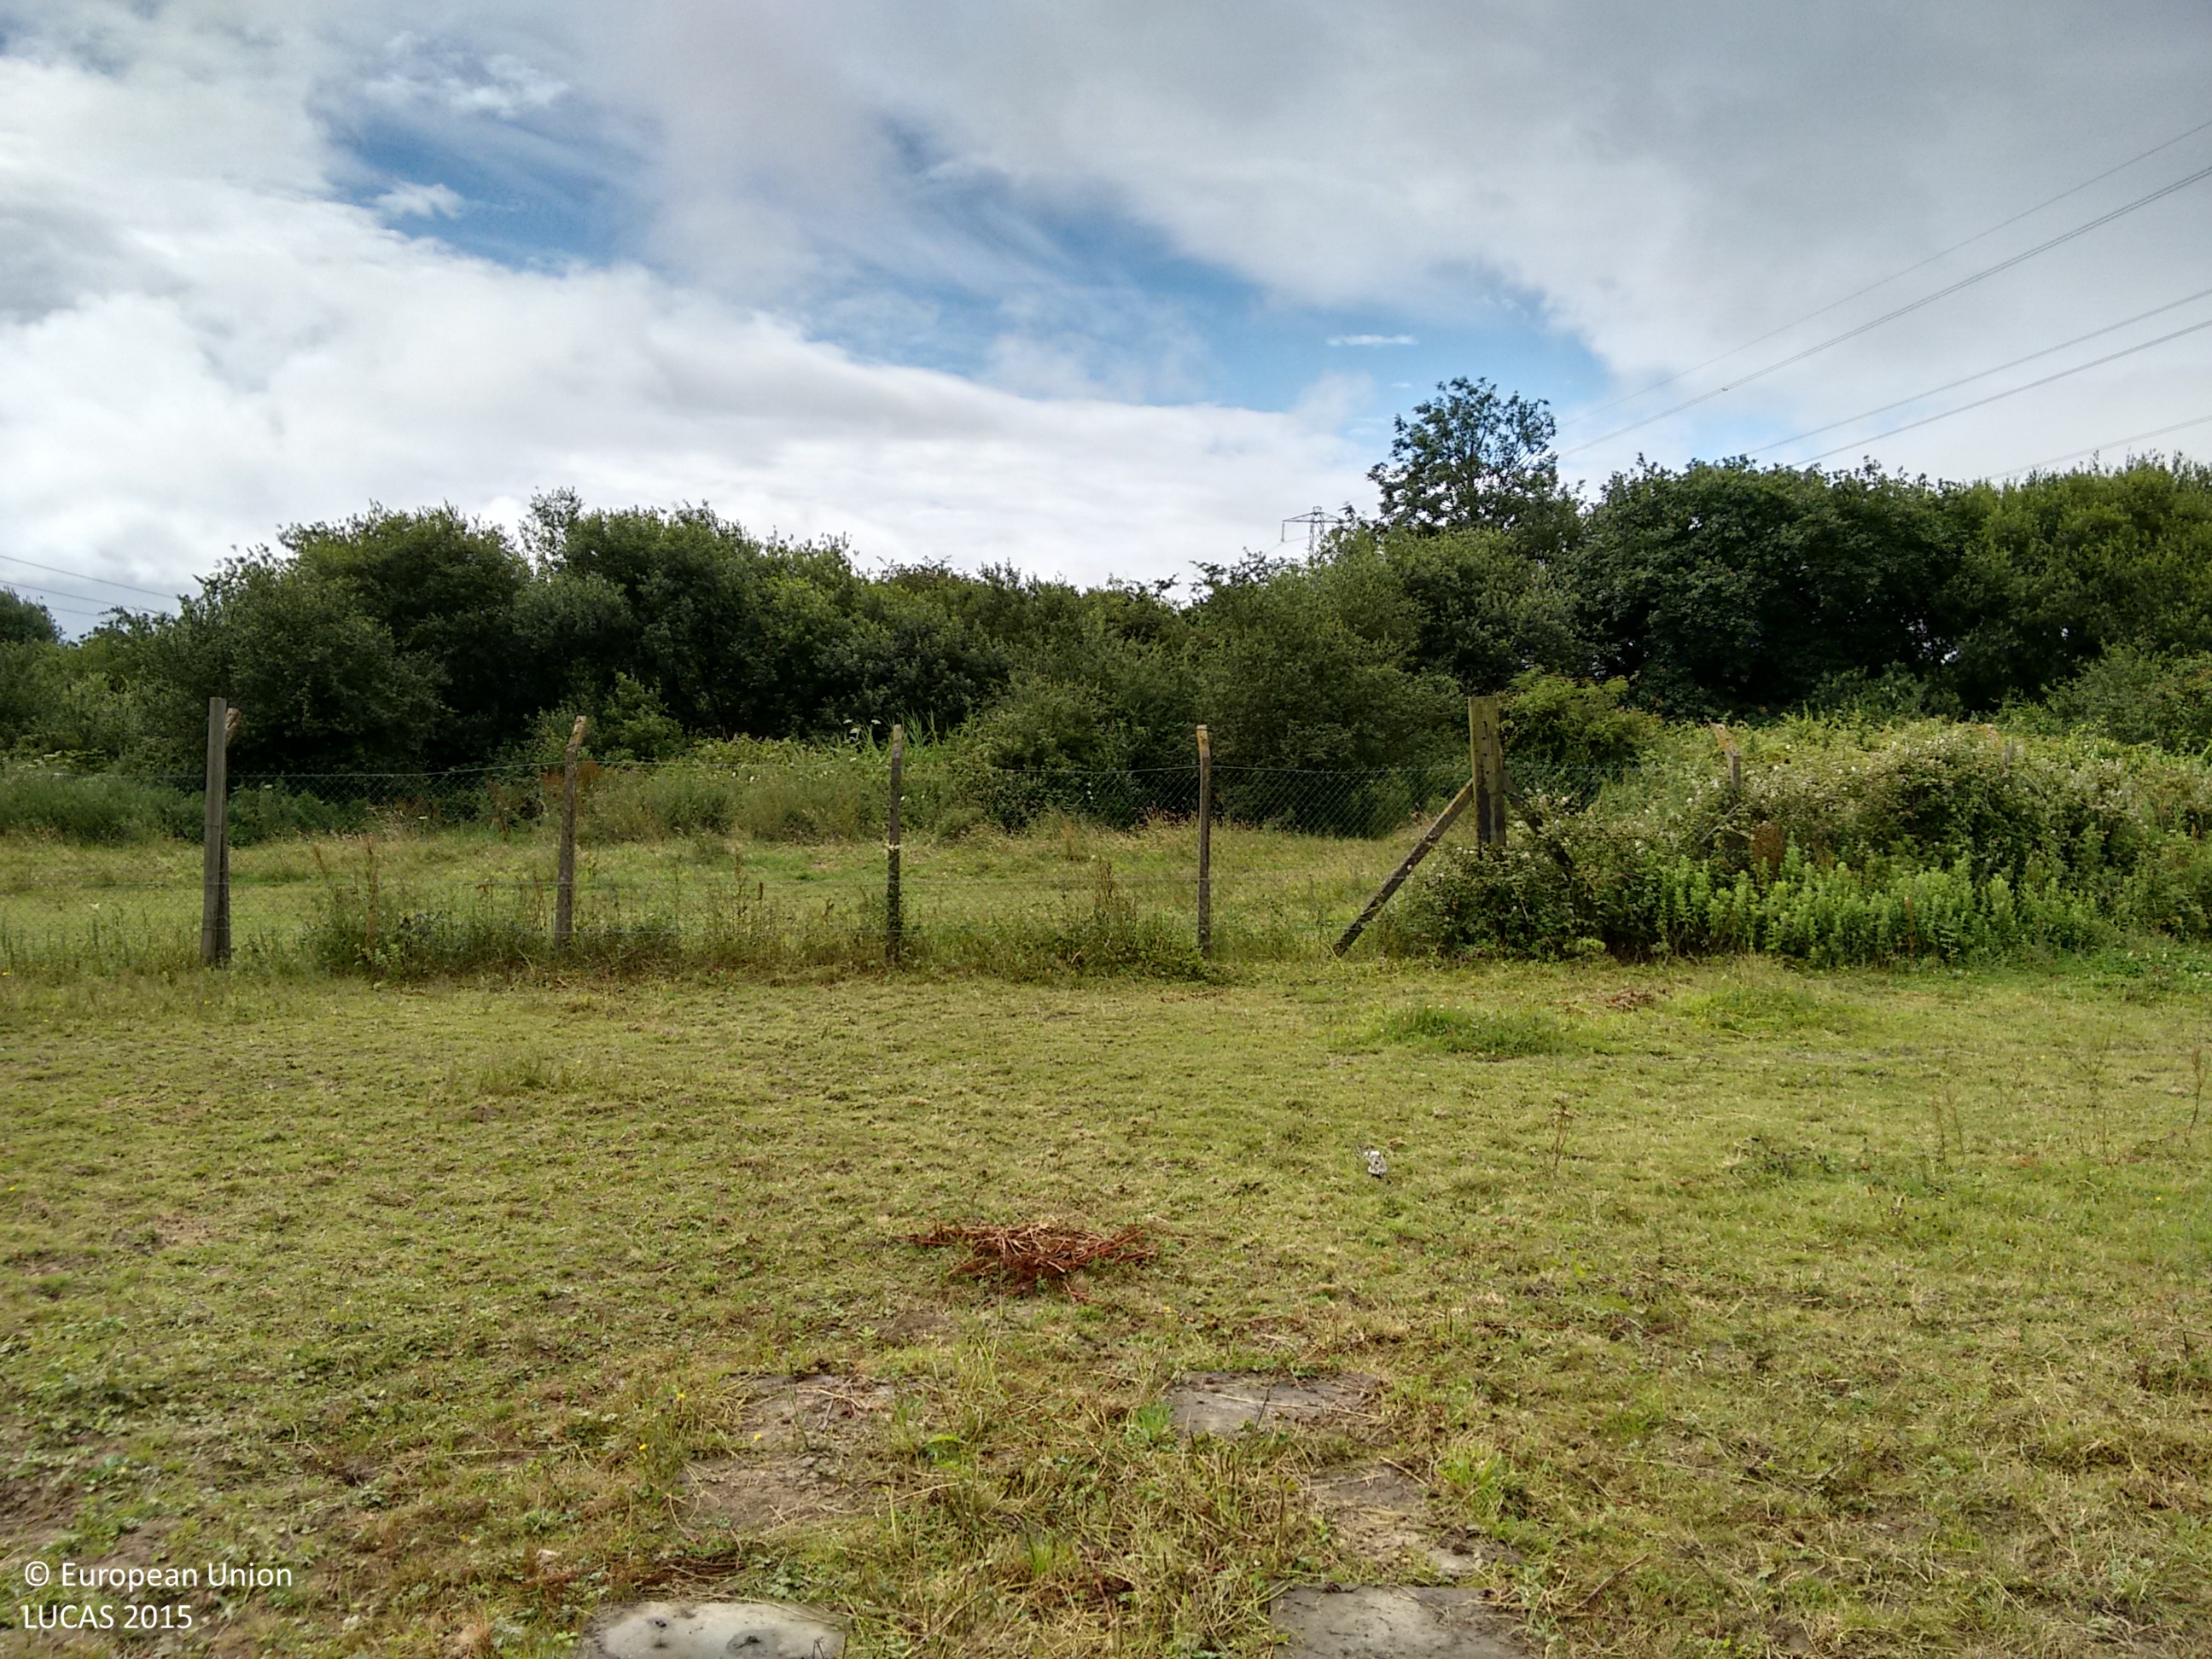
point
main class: Shrubland
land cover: Shrubland with sparse tree cover
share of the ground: > 75 %
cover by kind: shrubs 65 %, herbaceous plants 30 %, broadleaved forest trees 5 %
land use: Semi-natural and natural areas not in use
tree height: < 5 m
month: July
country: GB
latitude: 51.5543
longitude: -3.7476
